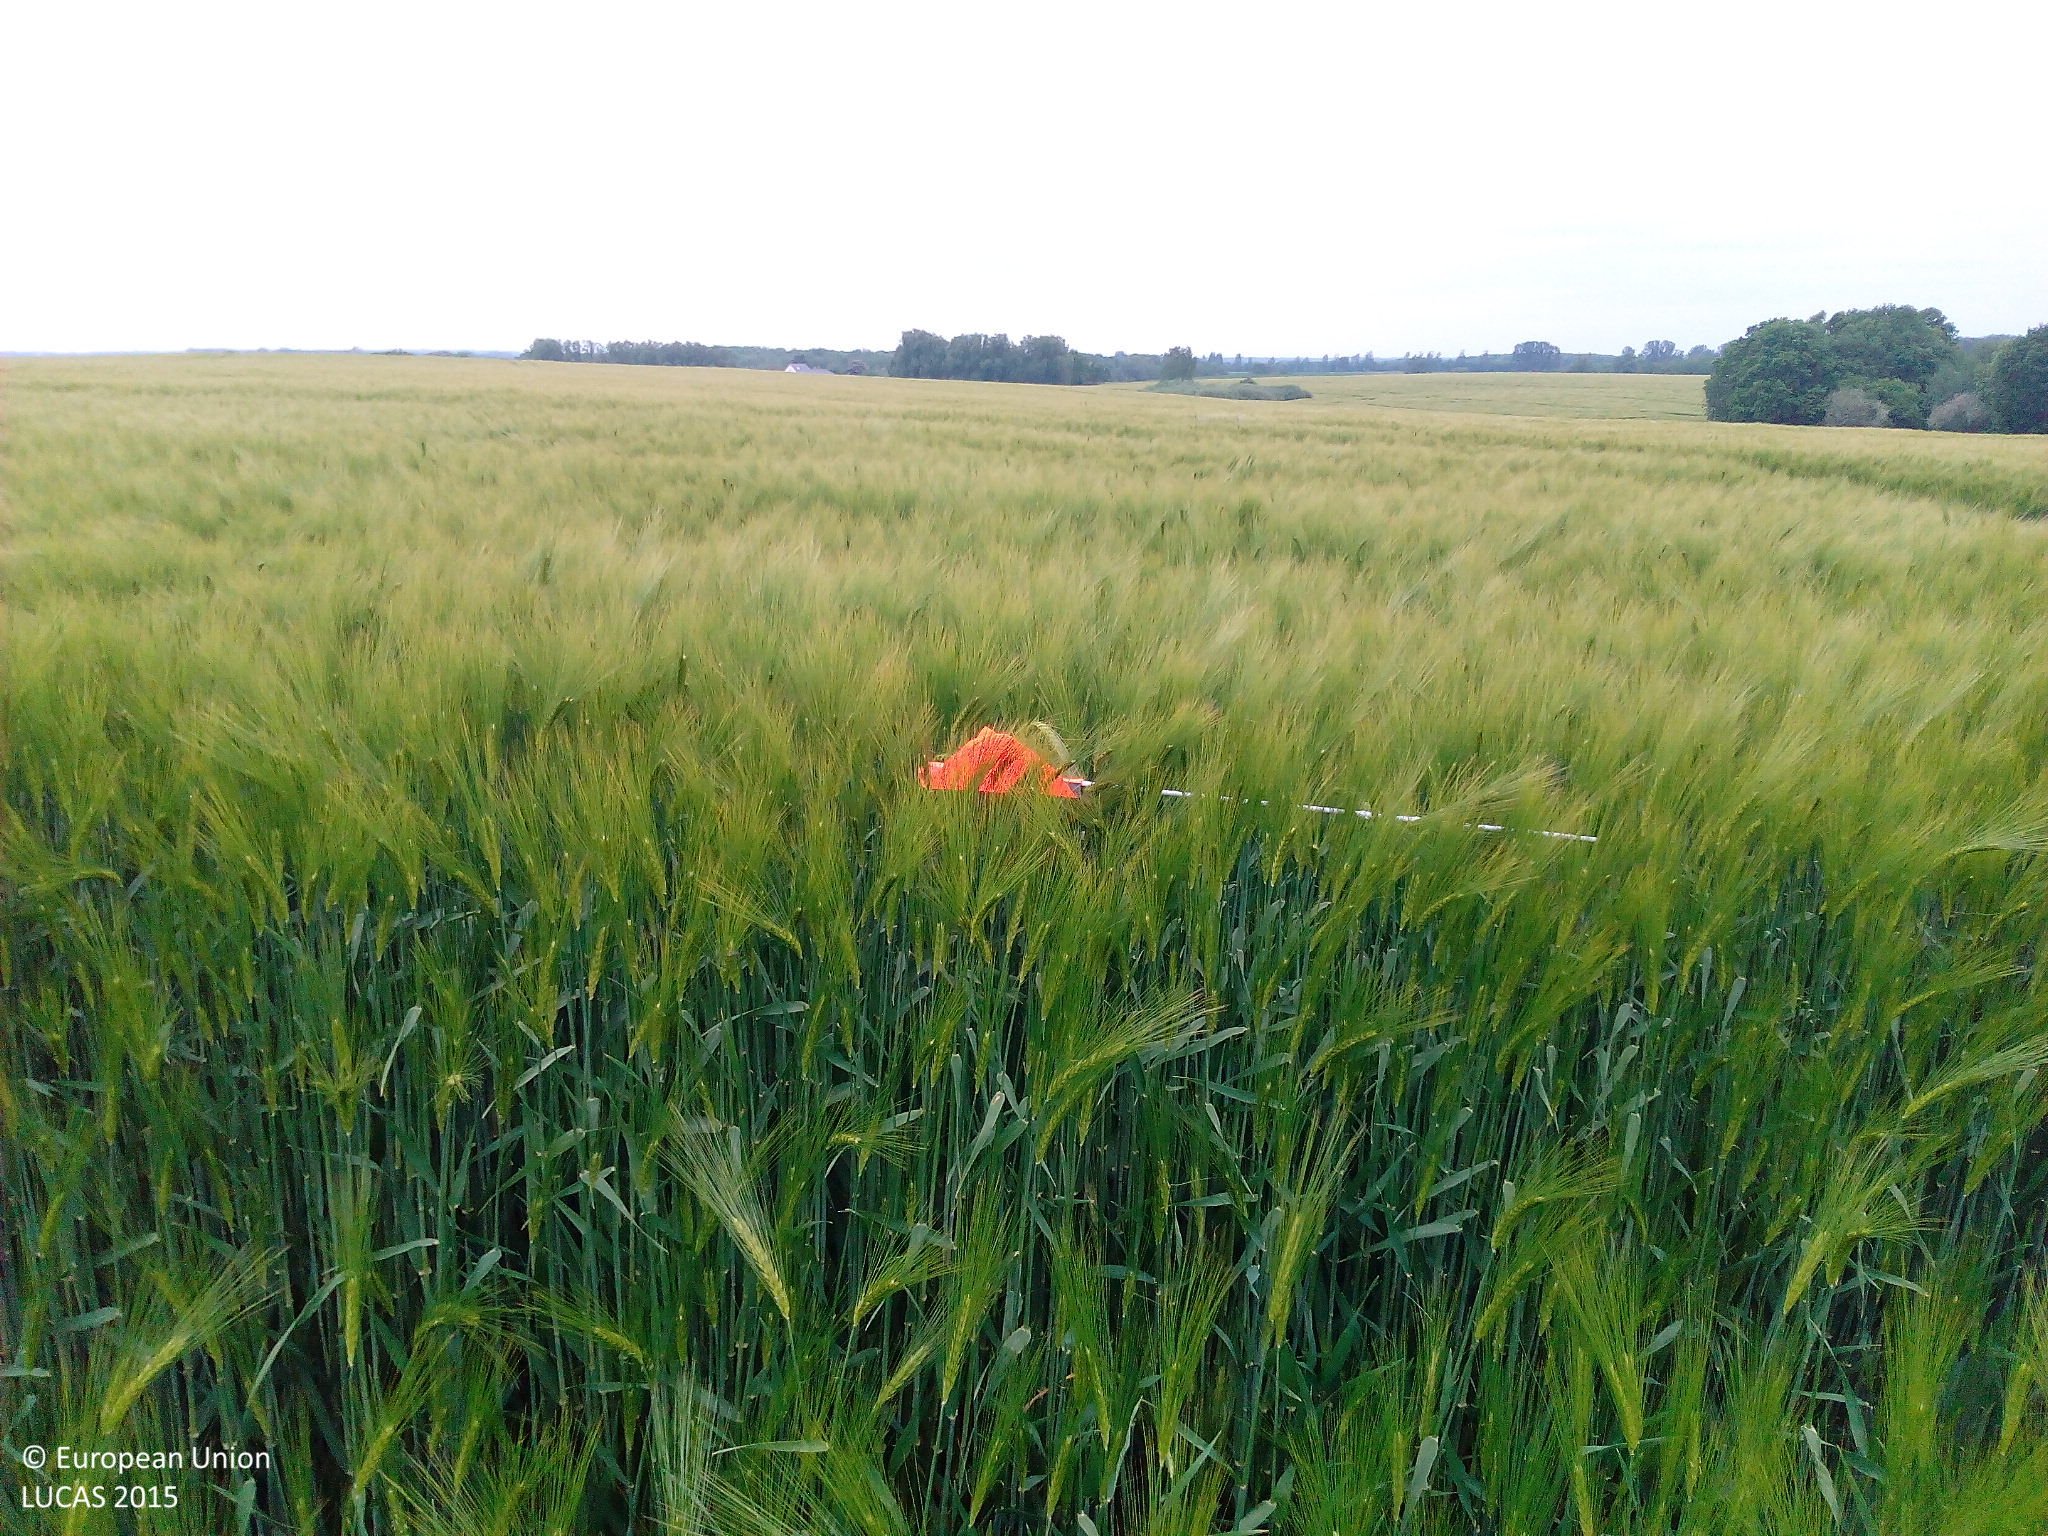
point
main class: Cropland
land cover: Barley
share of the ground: > 75 %
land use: Agriculture (excluding fallow land and kitchen gardens)
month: June
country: DE
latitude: 54.2923
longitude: 13.3024
